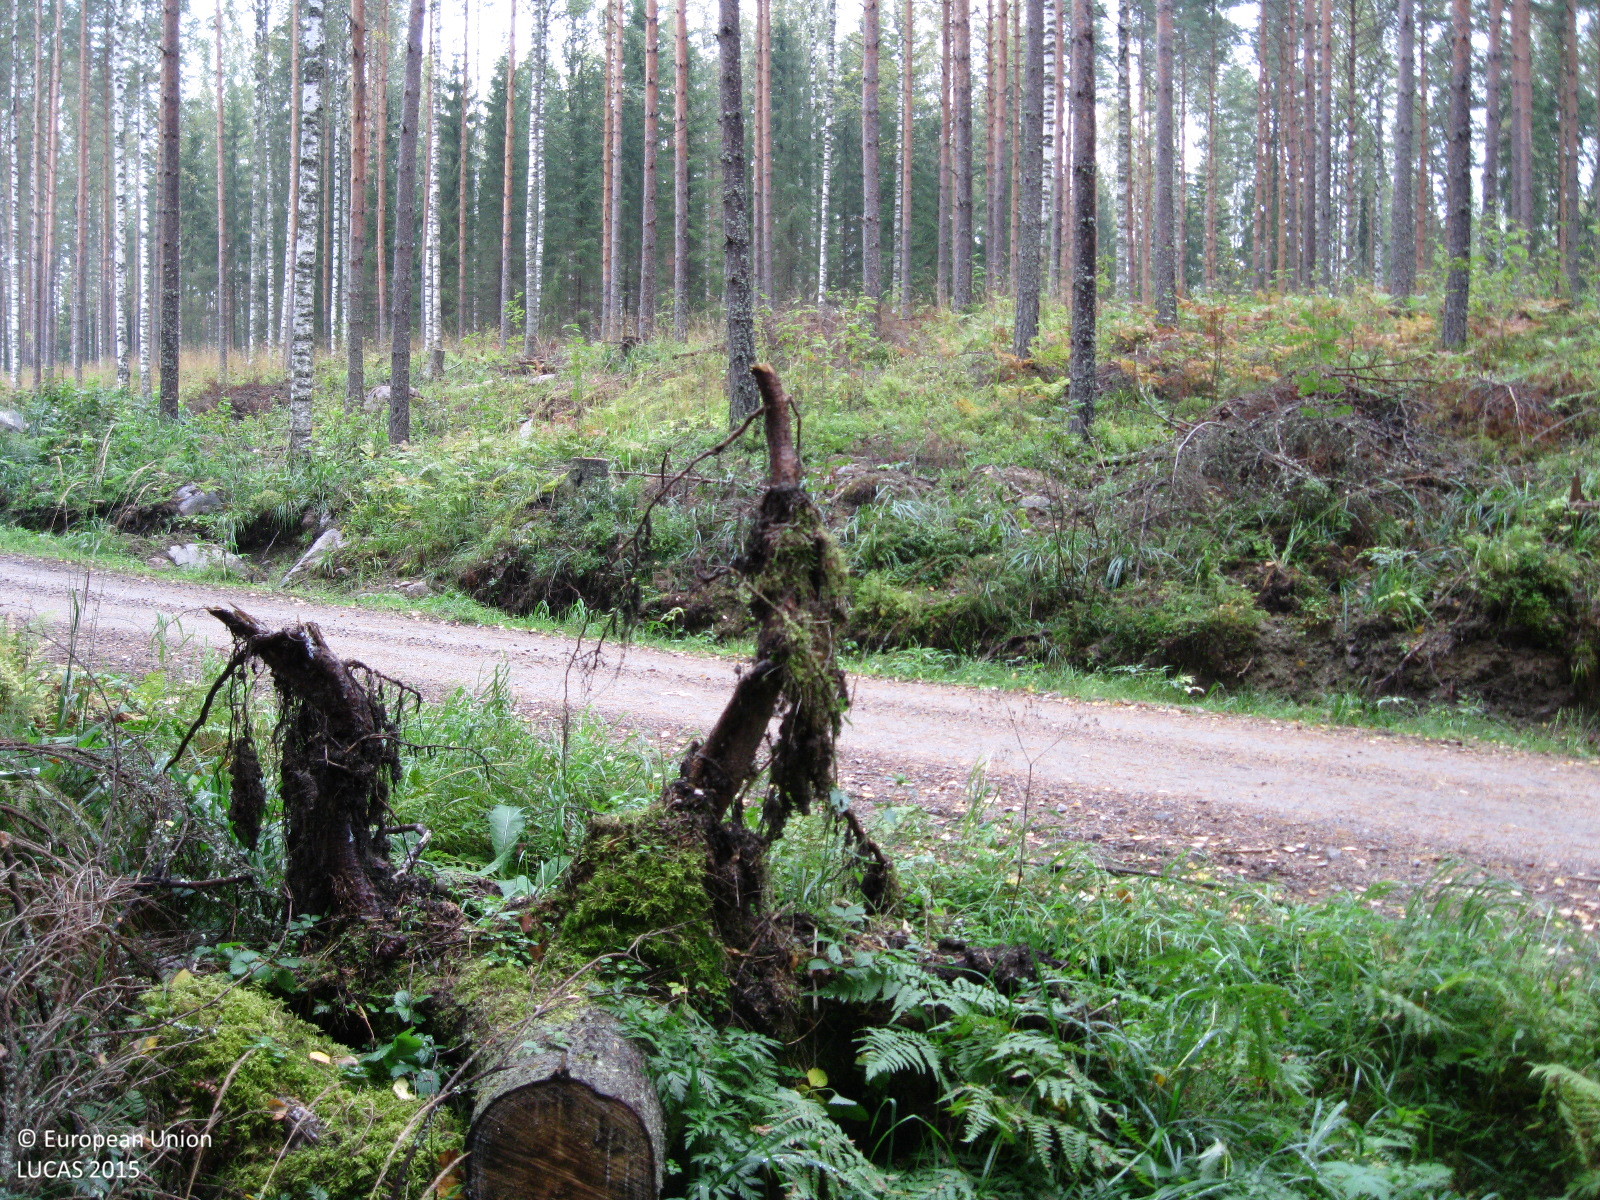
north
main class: Grassland
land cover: Spontaneously vegetated surfaces
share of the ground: > 75 %
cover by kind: herbaceous plants 100 %
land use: Forestry
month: September
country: FI
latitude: 60.9063
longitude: 24.9170
